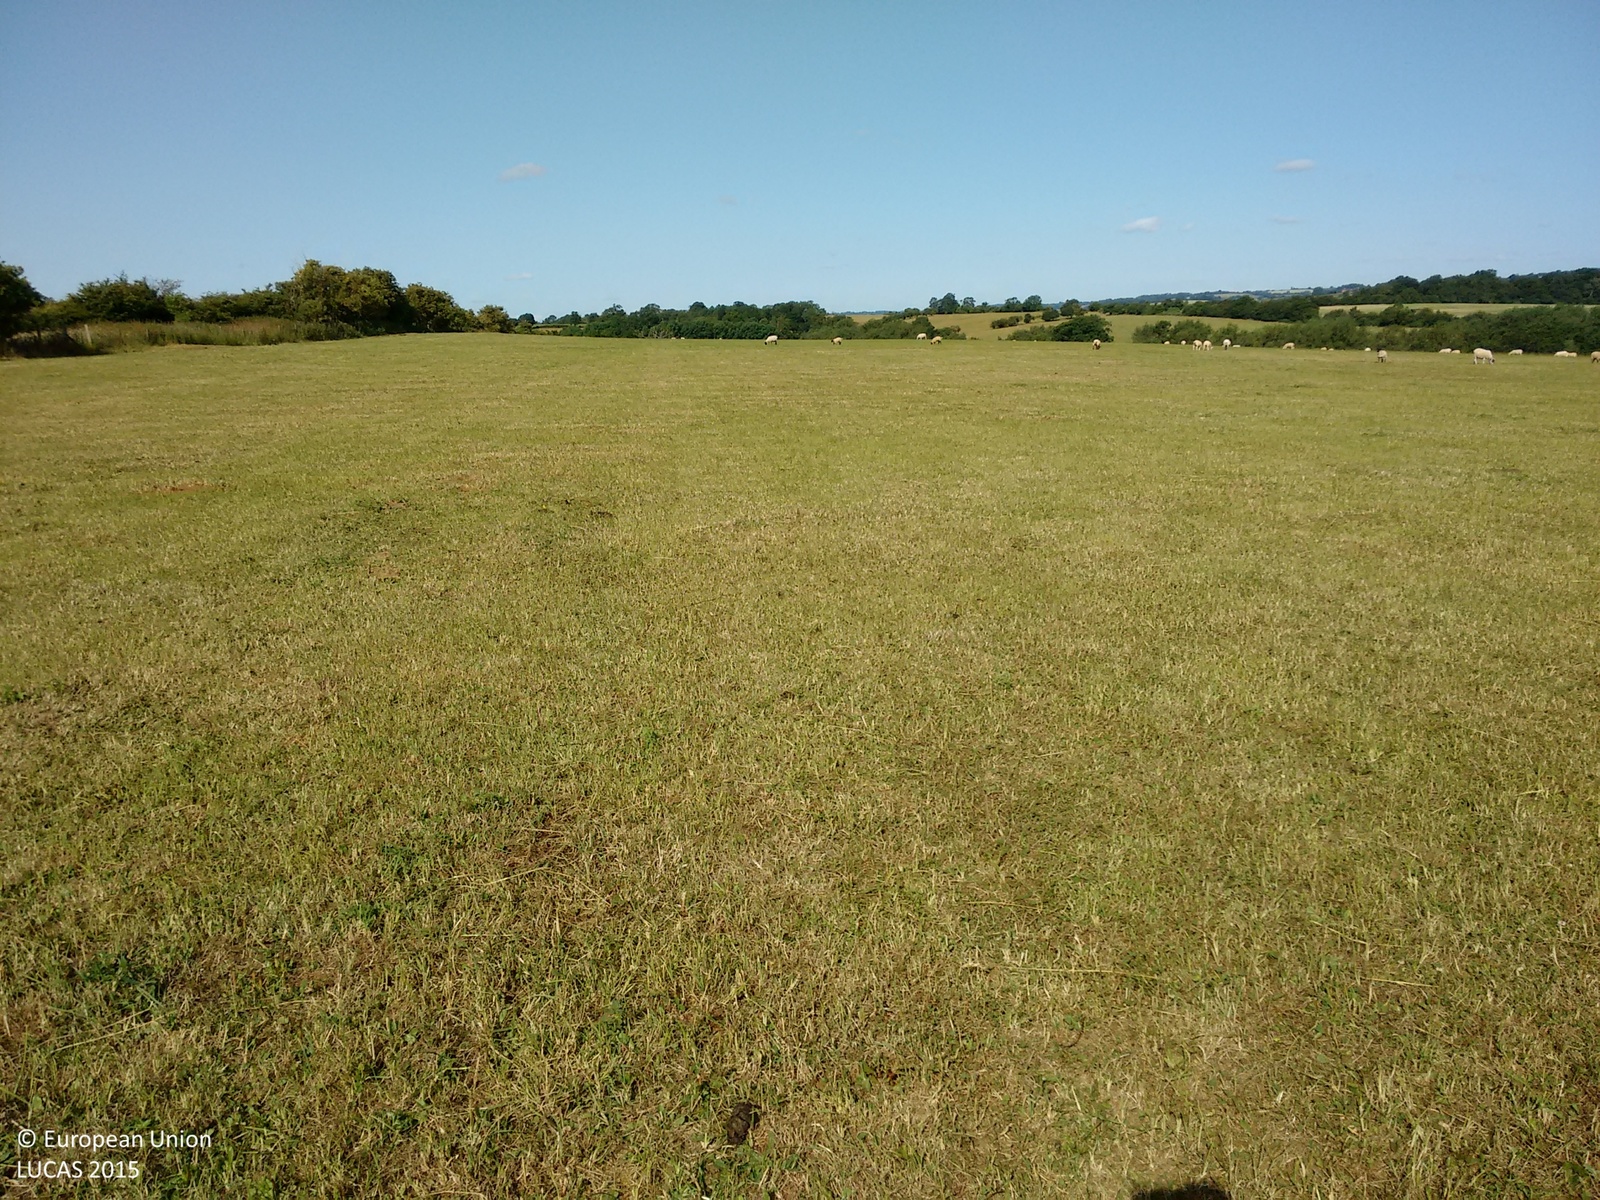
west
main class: Grassland
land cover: Grassland without tree/shrub cover
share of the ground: > 75 %
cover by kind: herbaceous plants 100 %
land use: Agriculture (excluding fallow land and kitchen gardens)
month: July
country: GB
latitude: 51.9632
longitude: -1.2985
